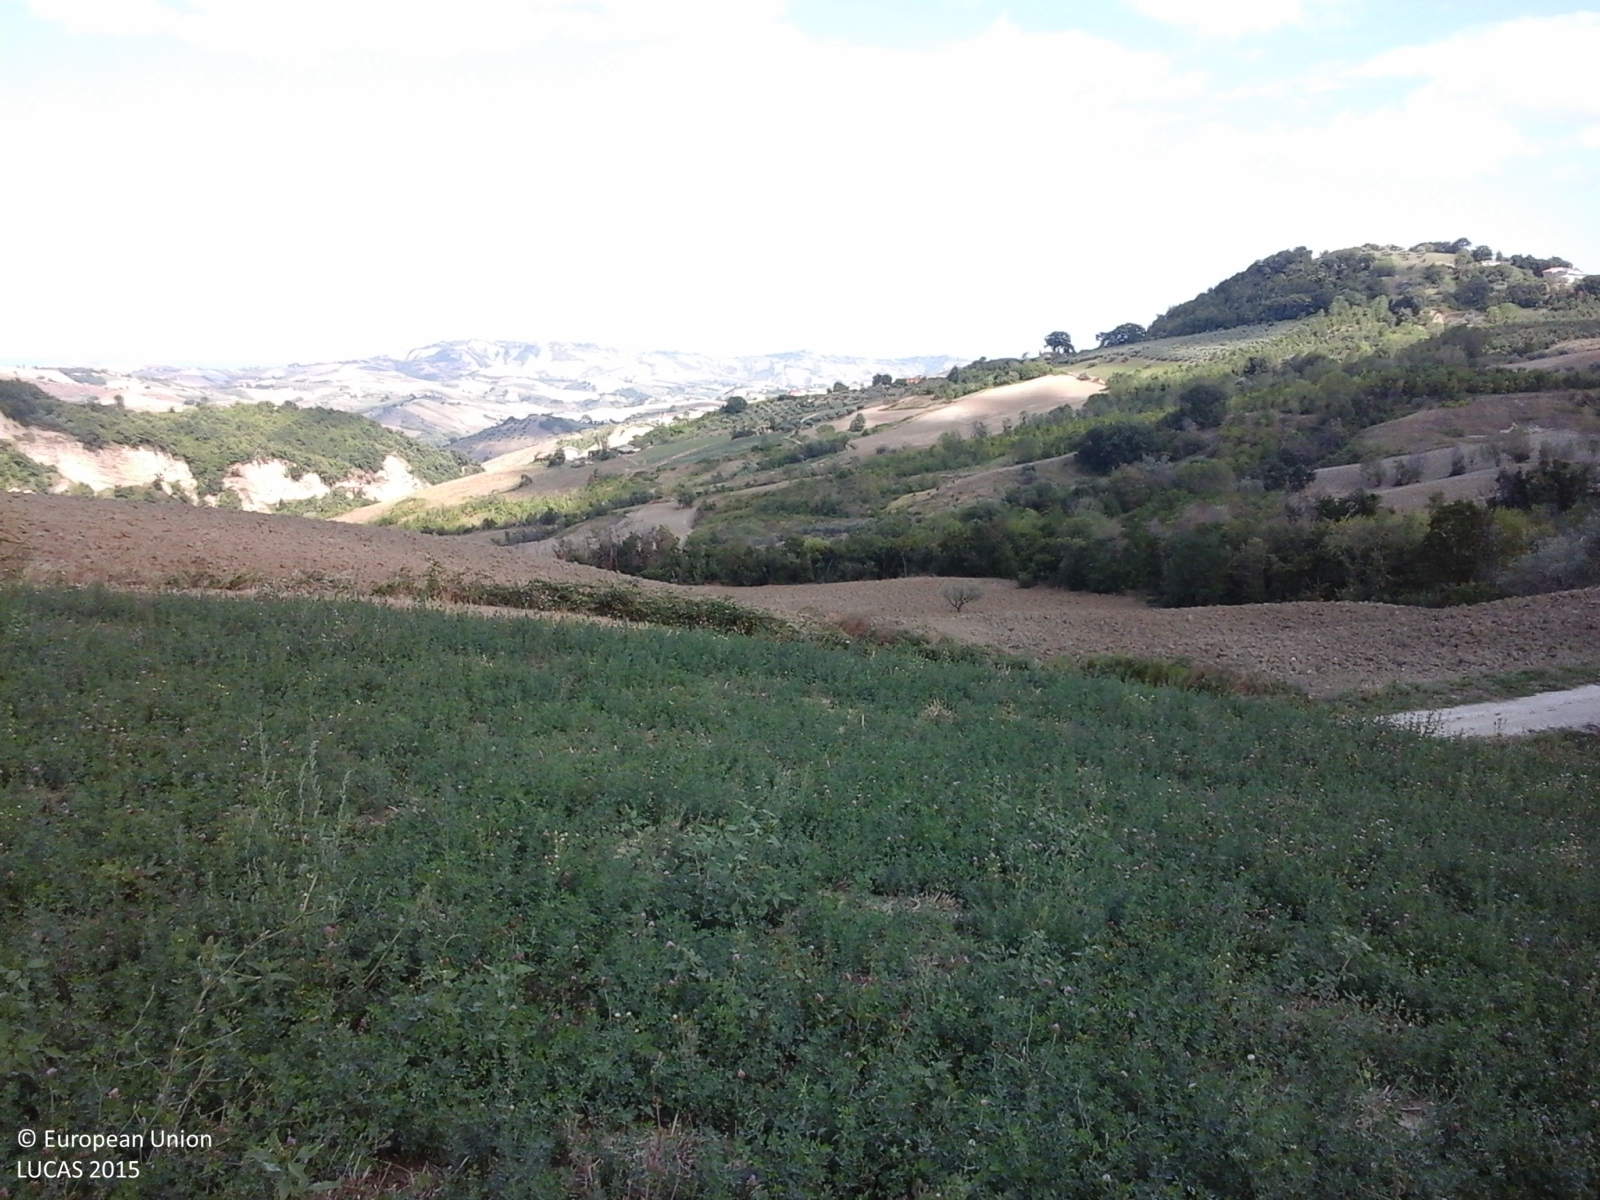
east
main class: Cropland
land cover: Lucerne
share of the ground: > 75 %
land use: Agriculture (excluding fallow land and kitchen gardens)
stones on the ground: < 10 %
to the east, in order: Lucerne; Electric lines; Durum wheat; Grass margins; Tracks; Grass margins; Other bare soil; Ditches and canals; Other bare soil; Shruby margins
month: August
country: IT
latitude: 42.5628
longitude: 13.8499
